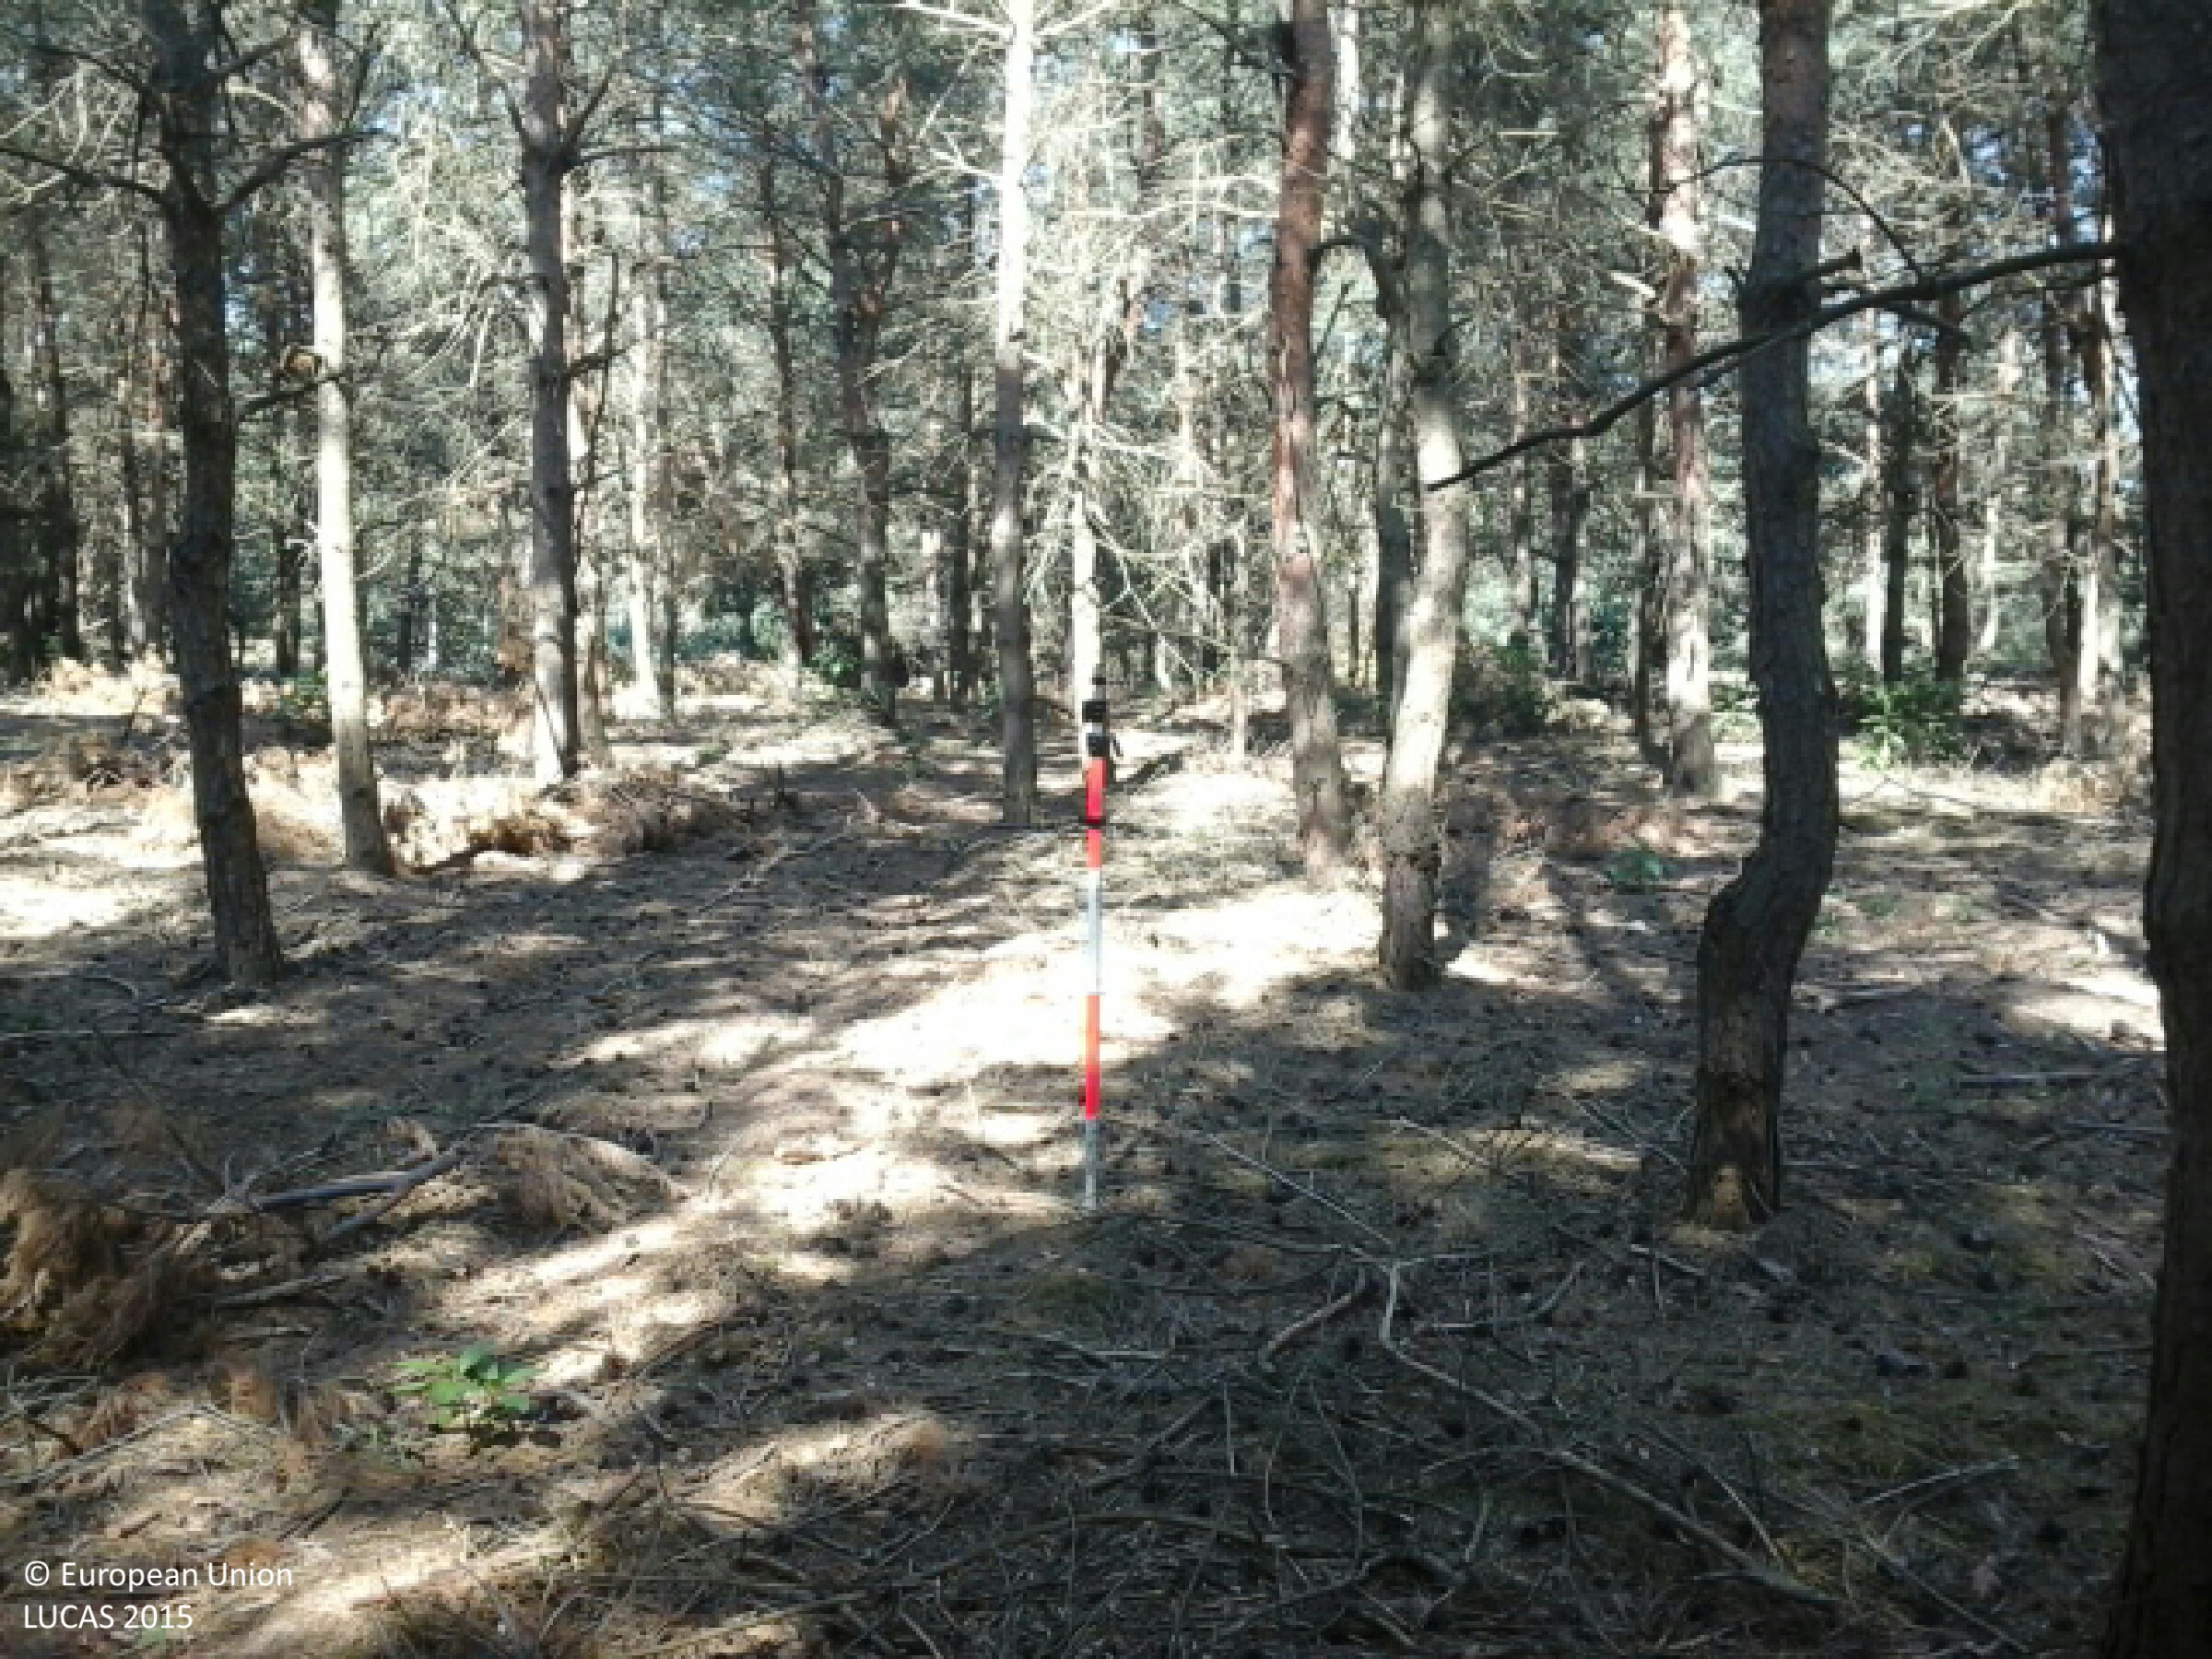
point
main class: Woodland
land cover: Pine dominated coniferous woodland
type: hemiboreal forest and nemoral coniferous forest and mixed broadleaved-coniferous forest
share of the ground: > 75 %
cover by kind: coniferous forest trees 85 %, consolidated bare surface 10 %, shrubs 5 %
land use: Forestry
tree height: > 5 m
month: July
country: HU
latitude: 47.9613
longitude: 22.2019
